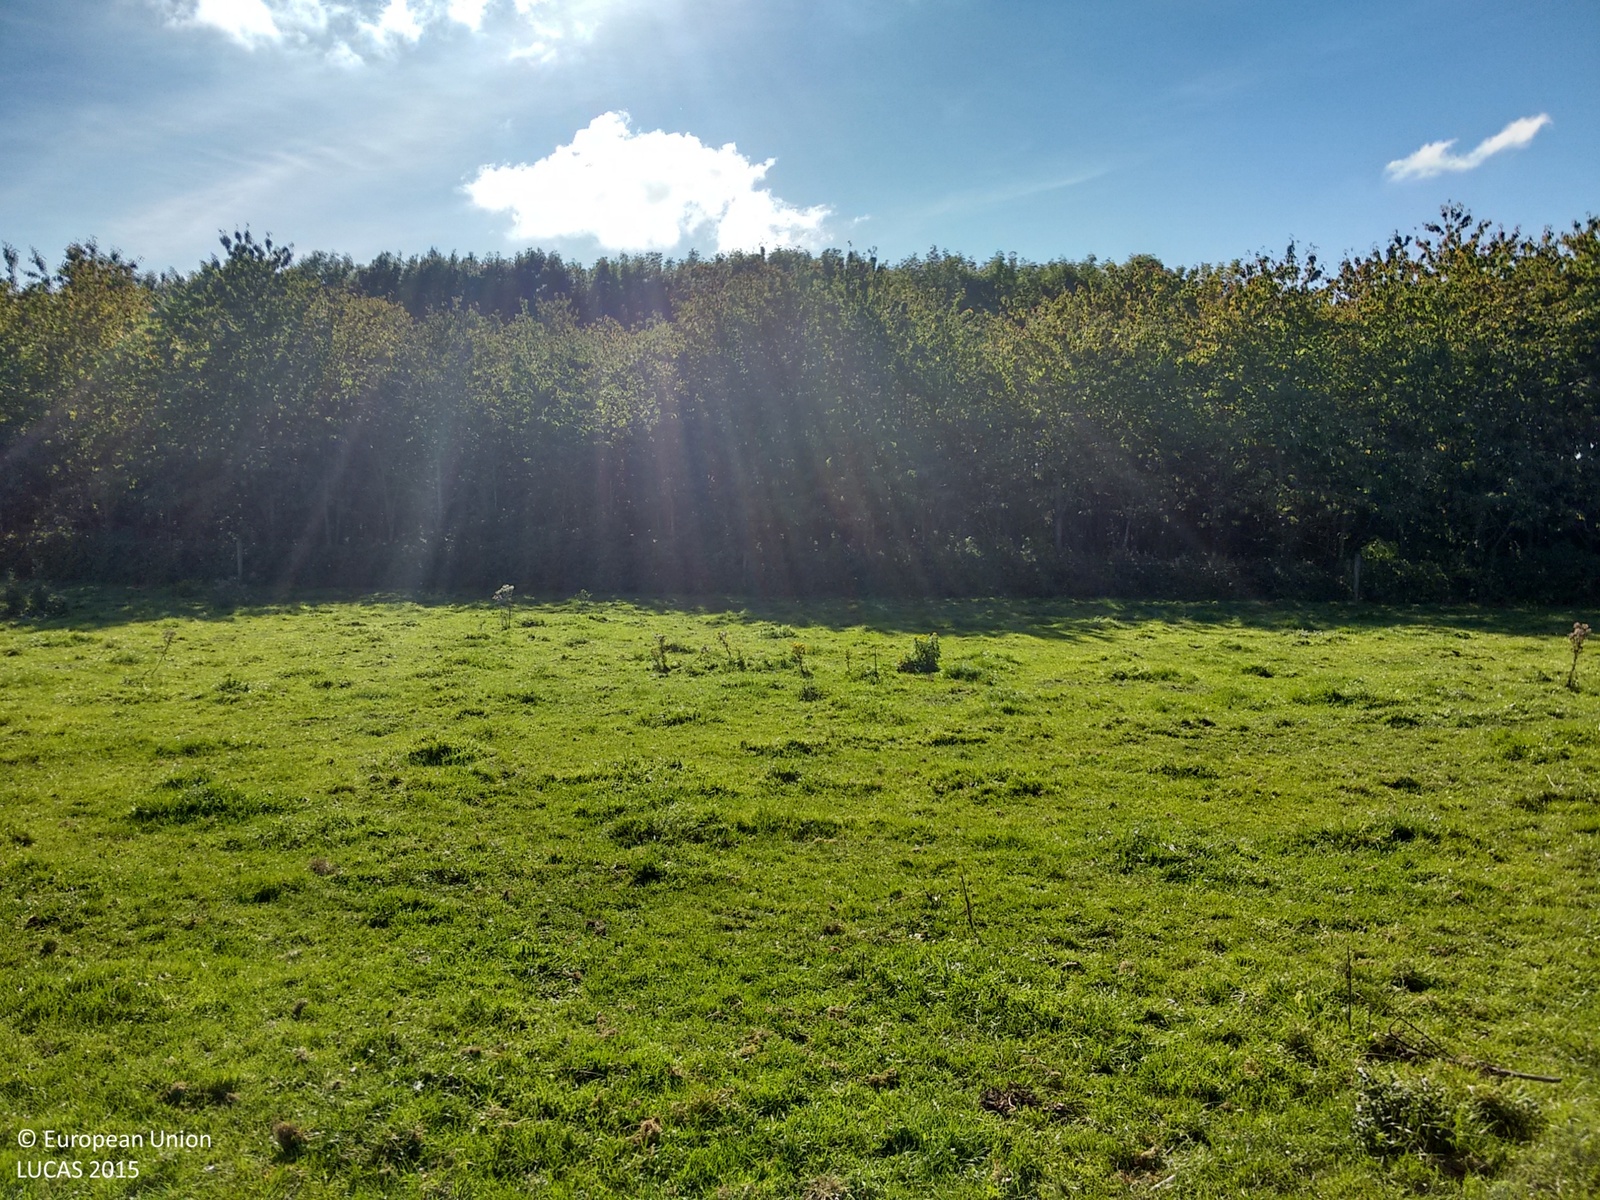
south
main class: Grassland
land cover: Grassland without tree/shrub cover
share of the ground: > 75 %
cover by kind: herbaceous plants 100 %
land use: Agriculture (excluding fallow land and kitchen gardens)
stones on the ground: < 10 %
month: October
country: IE
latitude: 52.9729
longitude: -7.4148
